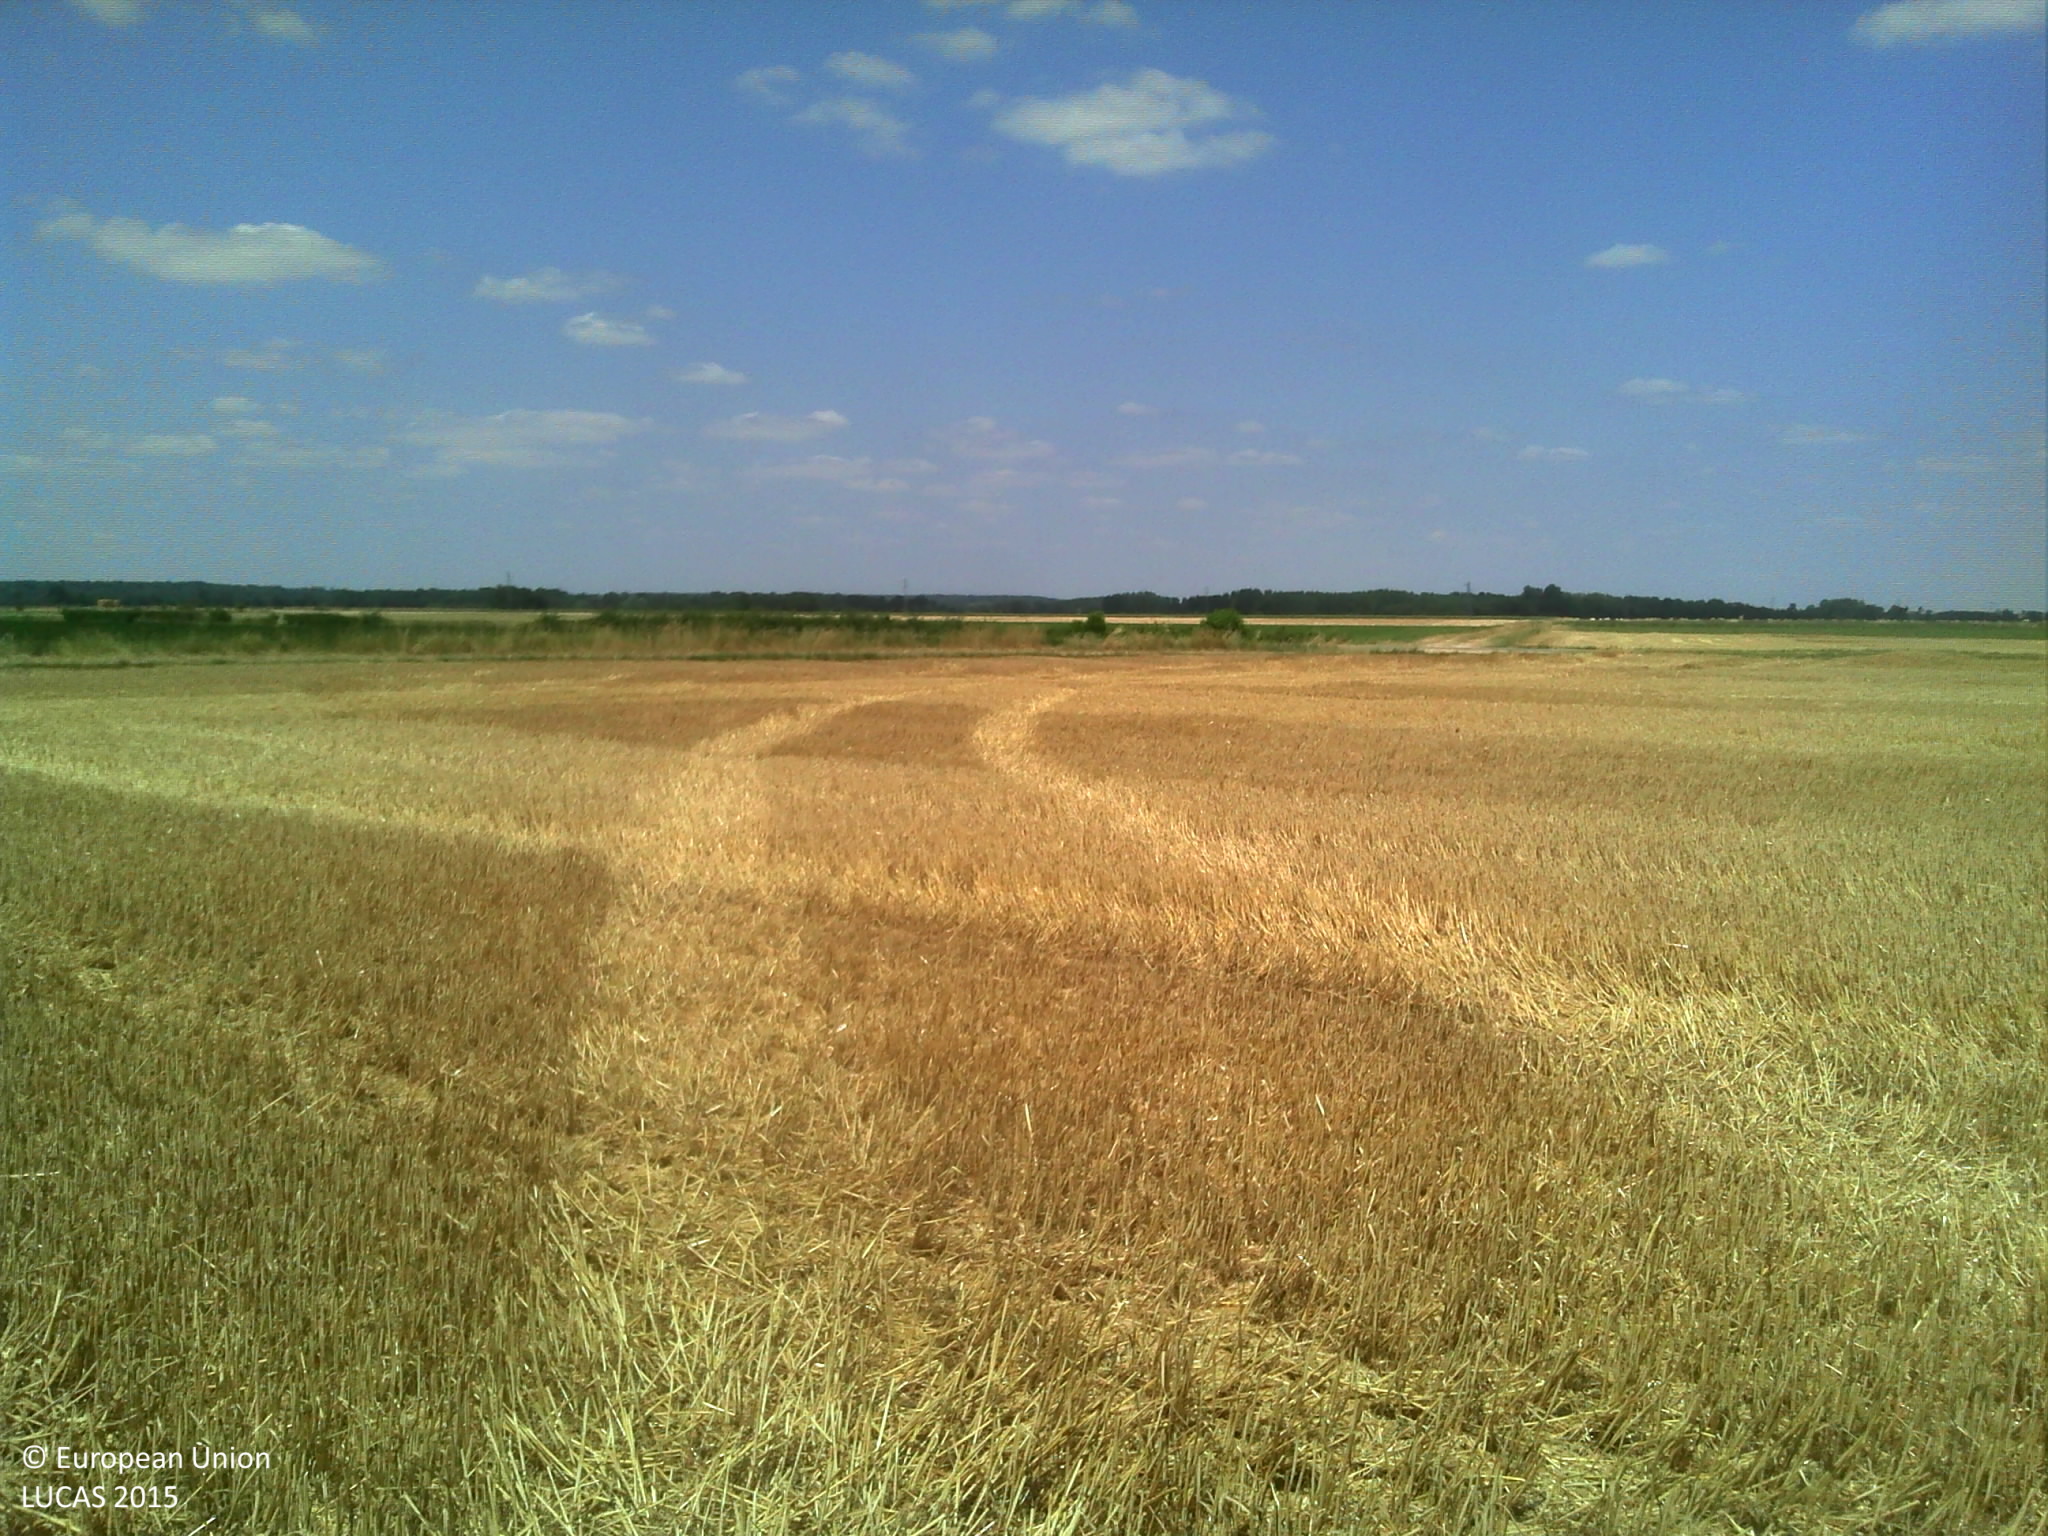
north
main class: Cropland
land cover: Common wheat
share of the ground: > 75 %
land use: Agriculture (excluding fallow land and kitchen gardens)
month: July
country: FR
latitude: 46.9055
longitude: 5.0784
